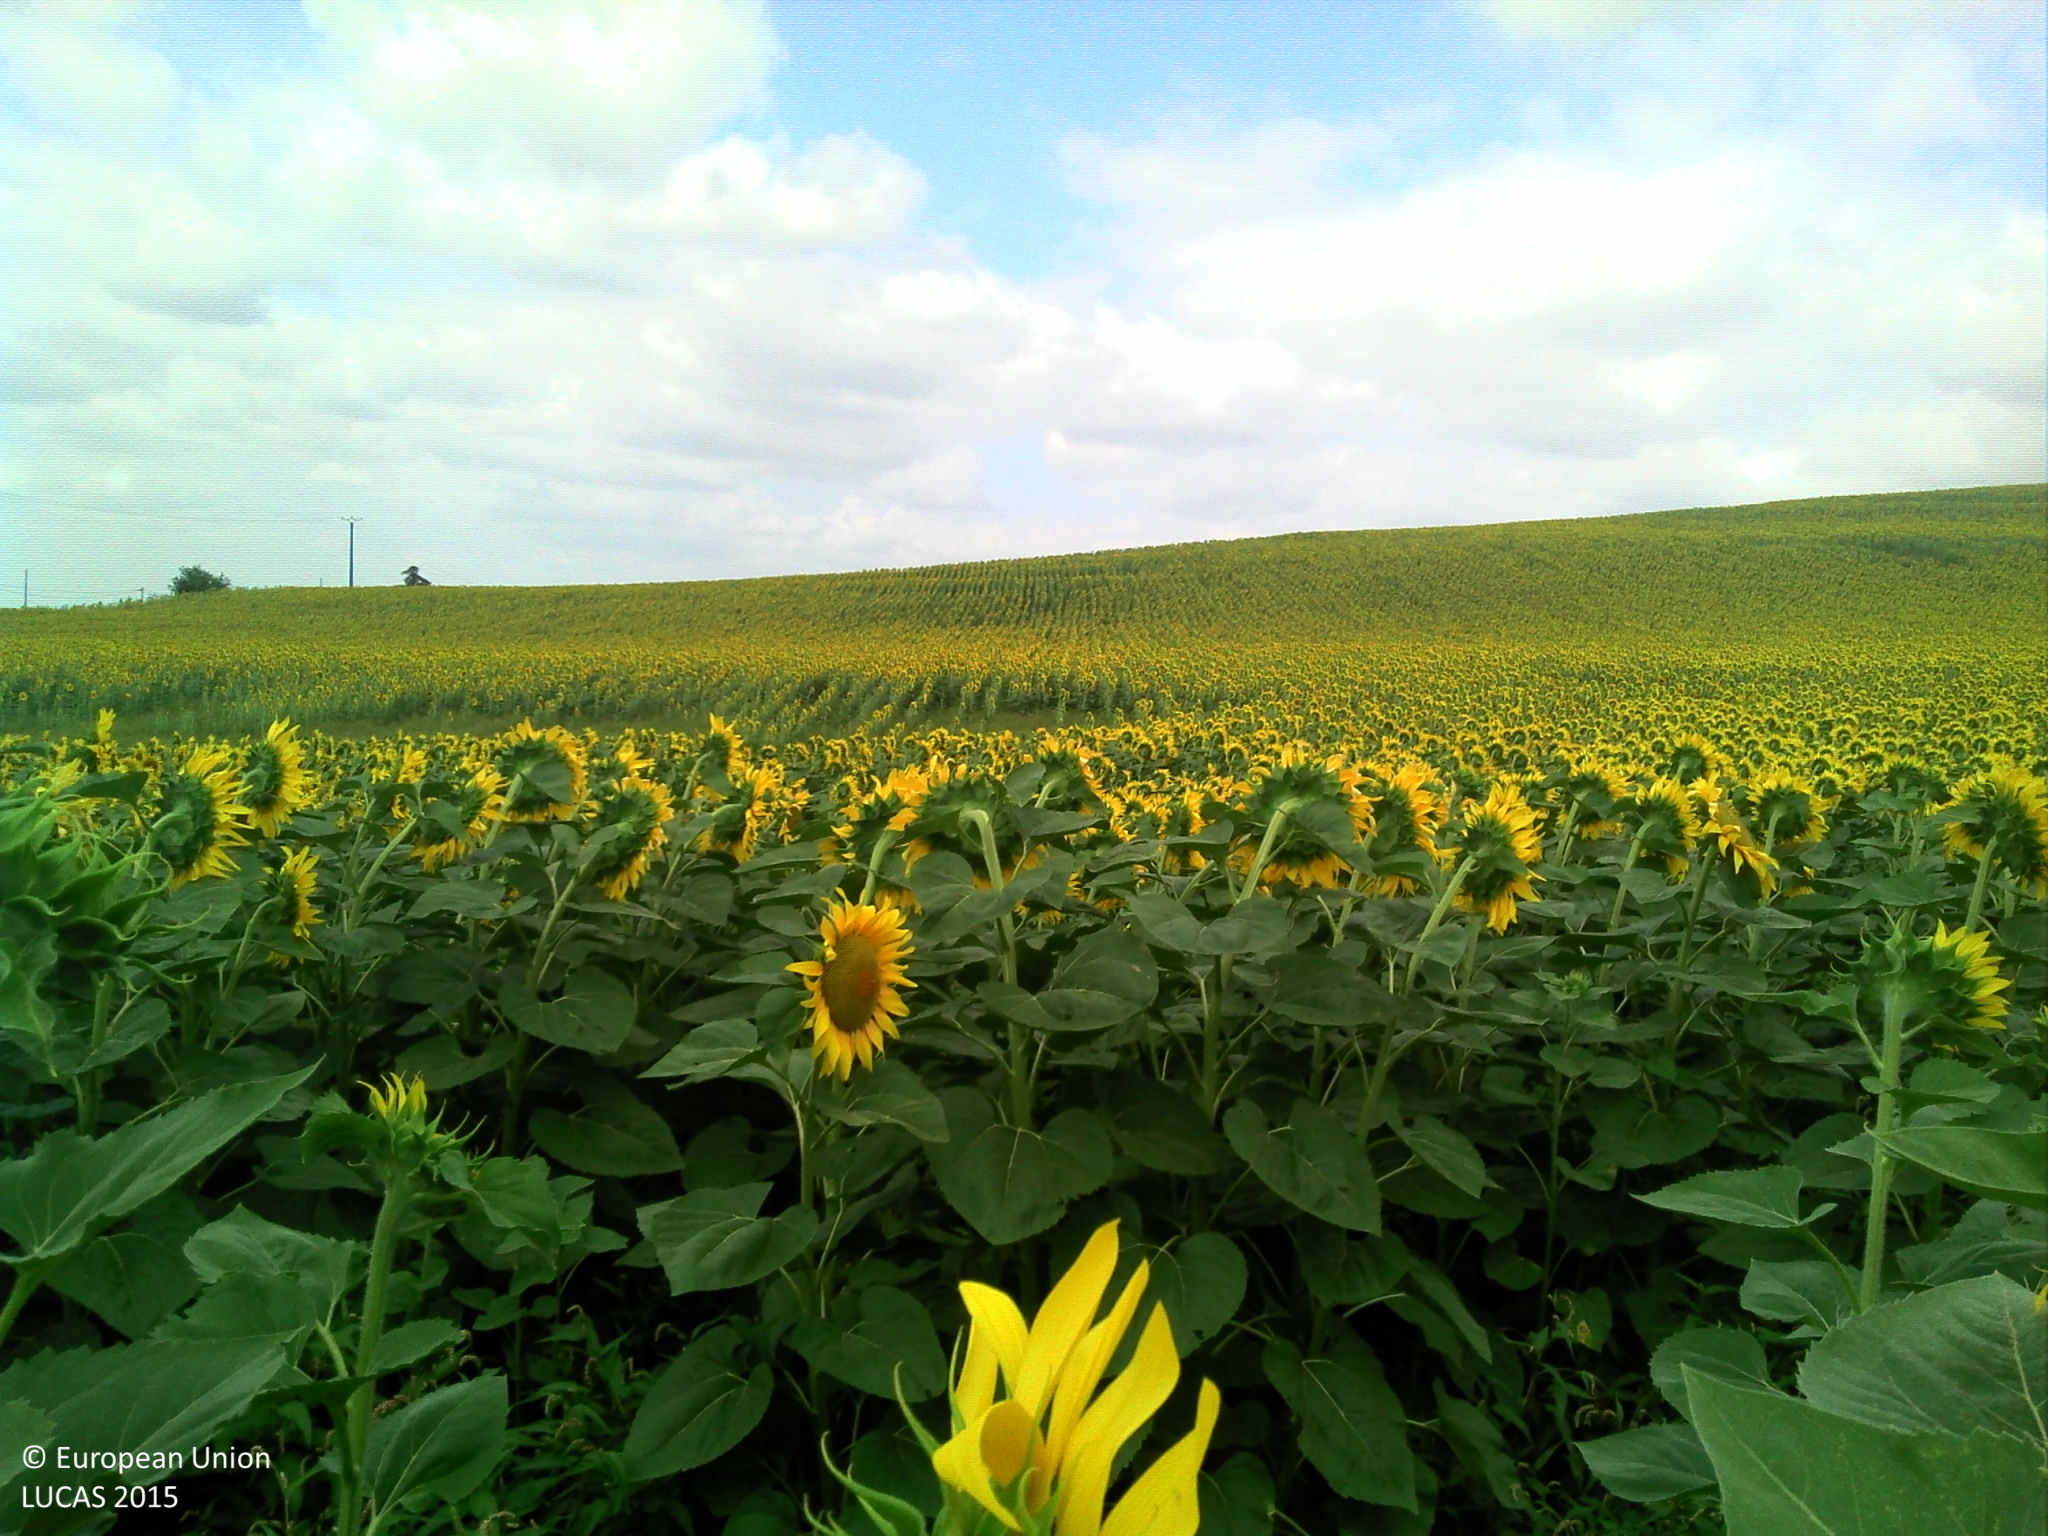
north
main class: Cropland
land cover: Sunflower
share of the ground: > 75 %
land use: Agriculture (excluding fallow land and kitchen gardens)
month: July
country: FR
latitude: 43.8304
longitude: 0.9832
